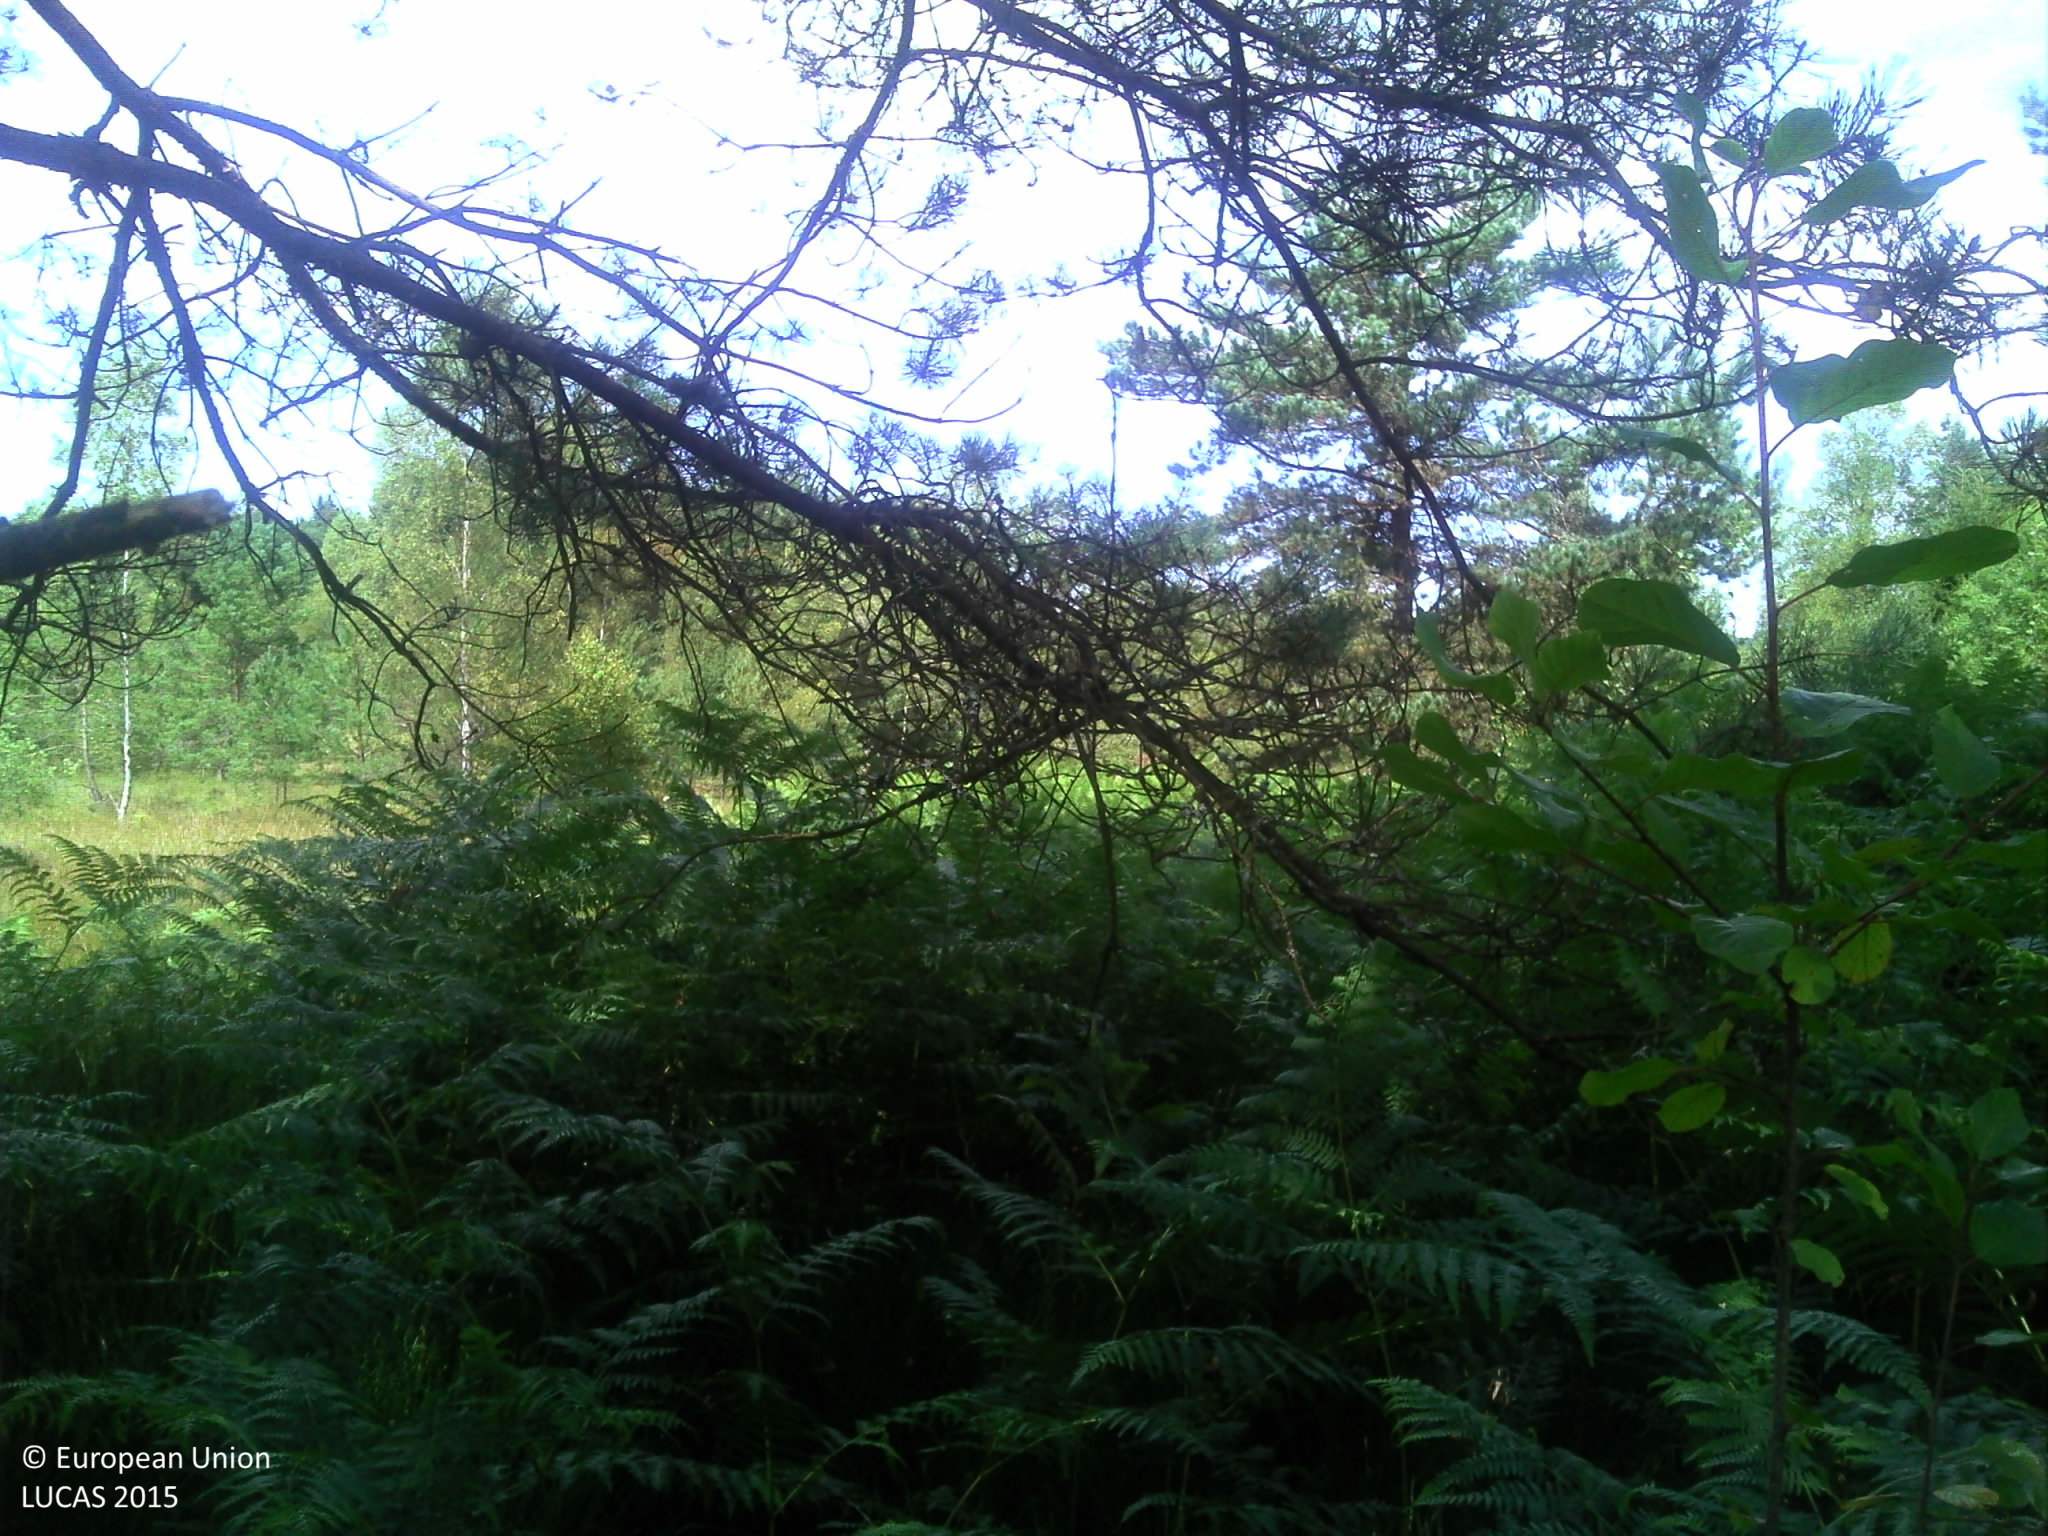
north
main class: Woodland
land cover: Broadleaved woodland
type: non-riverine alder, birch or aspen forest
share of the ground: > 75 %
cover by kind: shrubs 45 %, broadleaved forest trees 35 %, herbaceous plants 20 %
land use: Semi-natural and natural areas not in use
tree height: > 5 m
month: July
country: FR
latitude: 45.6236
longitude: 1.8507
